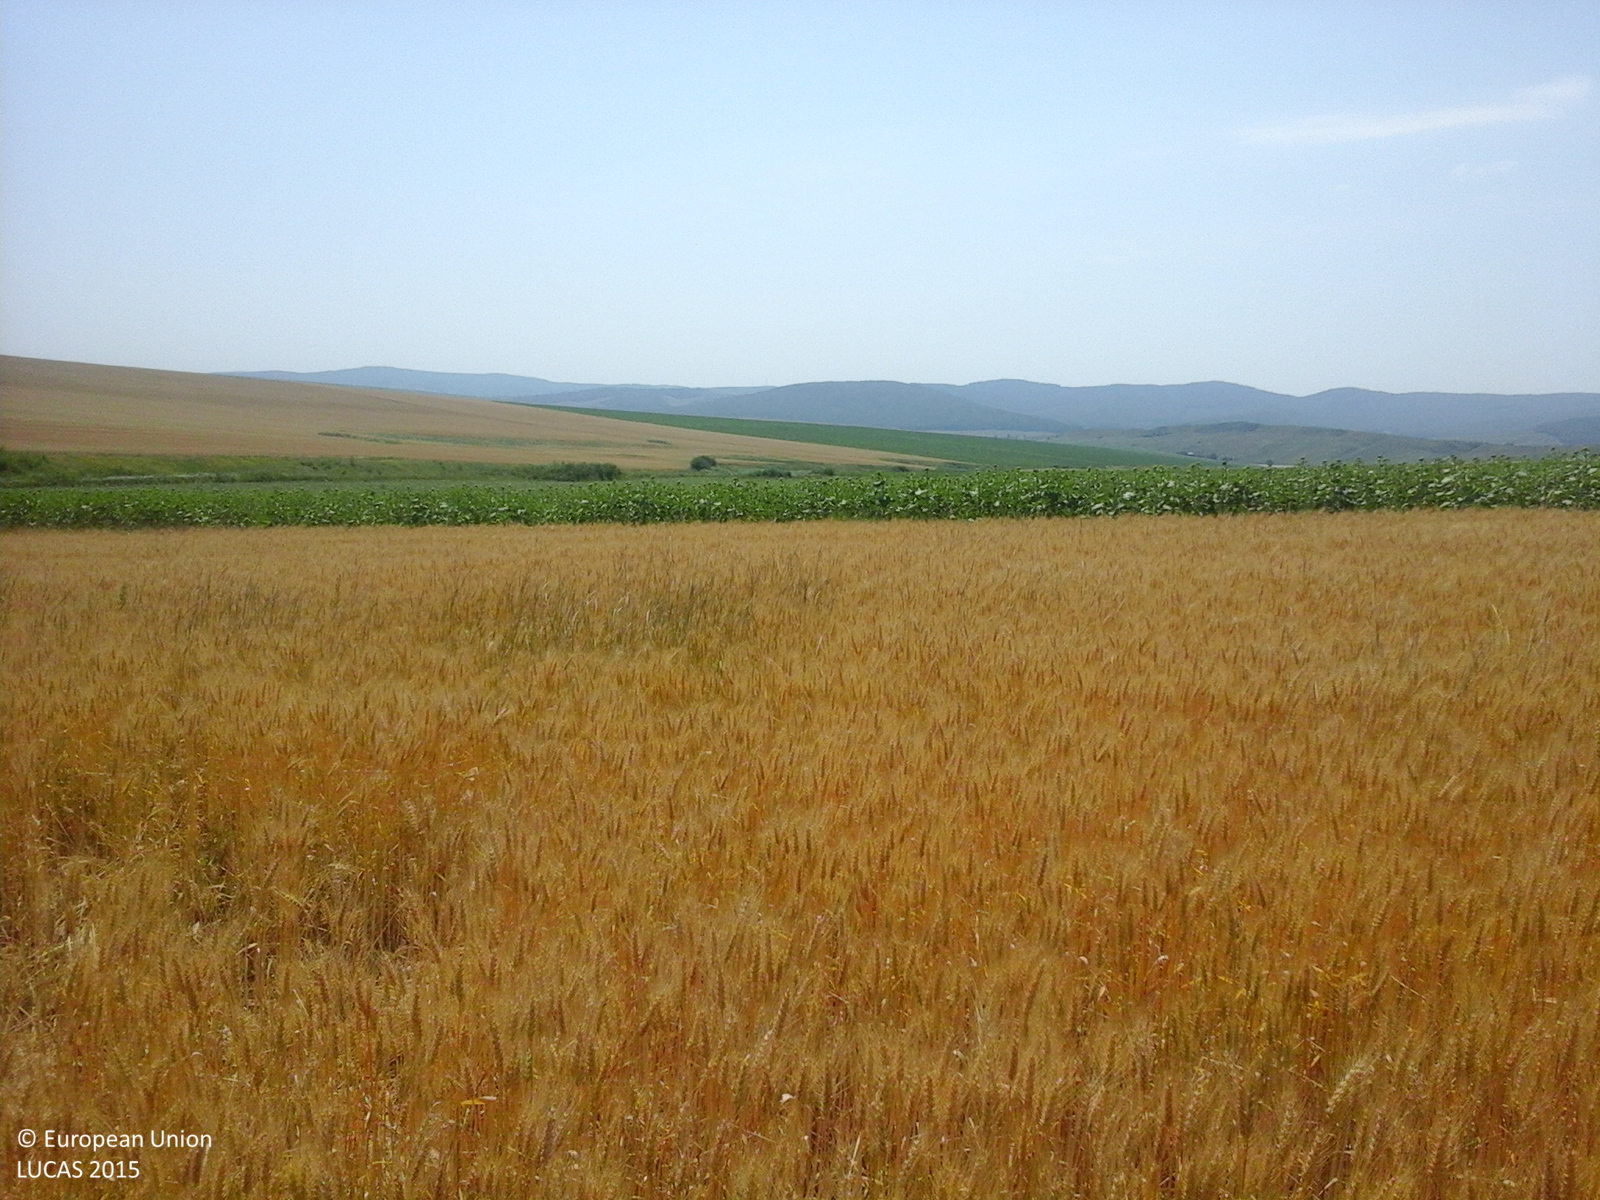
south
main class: Cropland
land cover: Common wheat
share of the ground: > 75 %
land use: Agriculture (excluding fallow land and kitchen gardens)
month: June
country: RO
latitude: 46.8769
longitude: 27.3096
